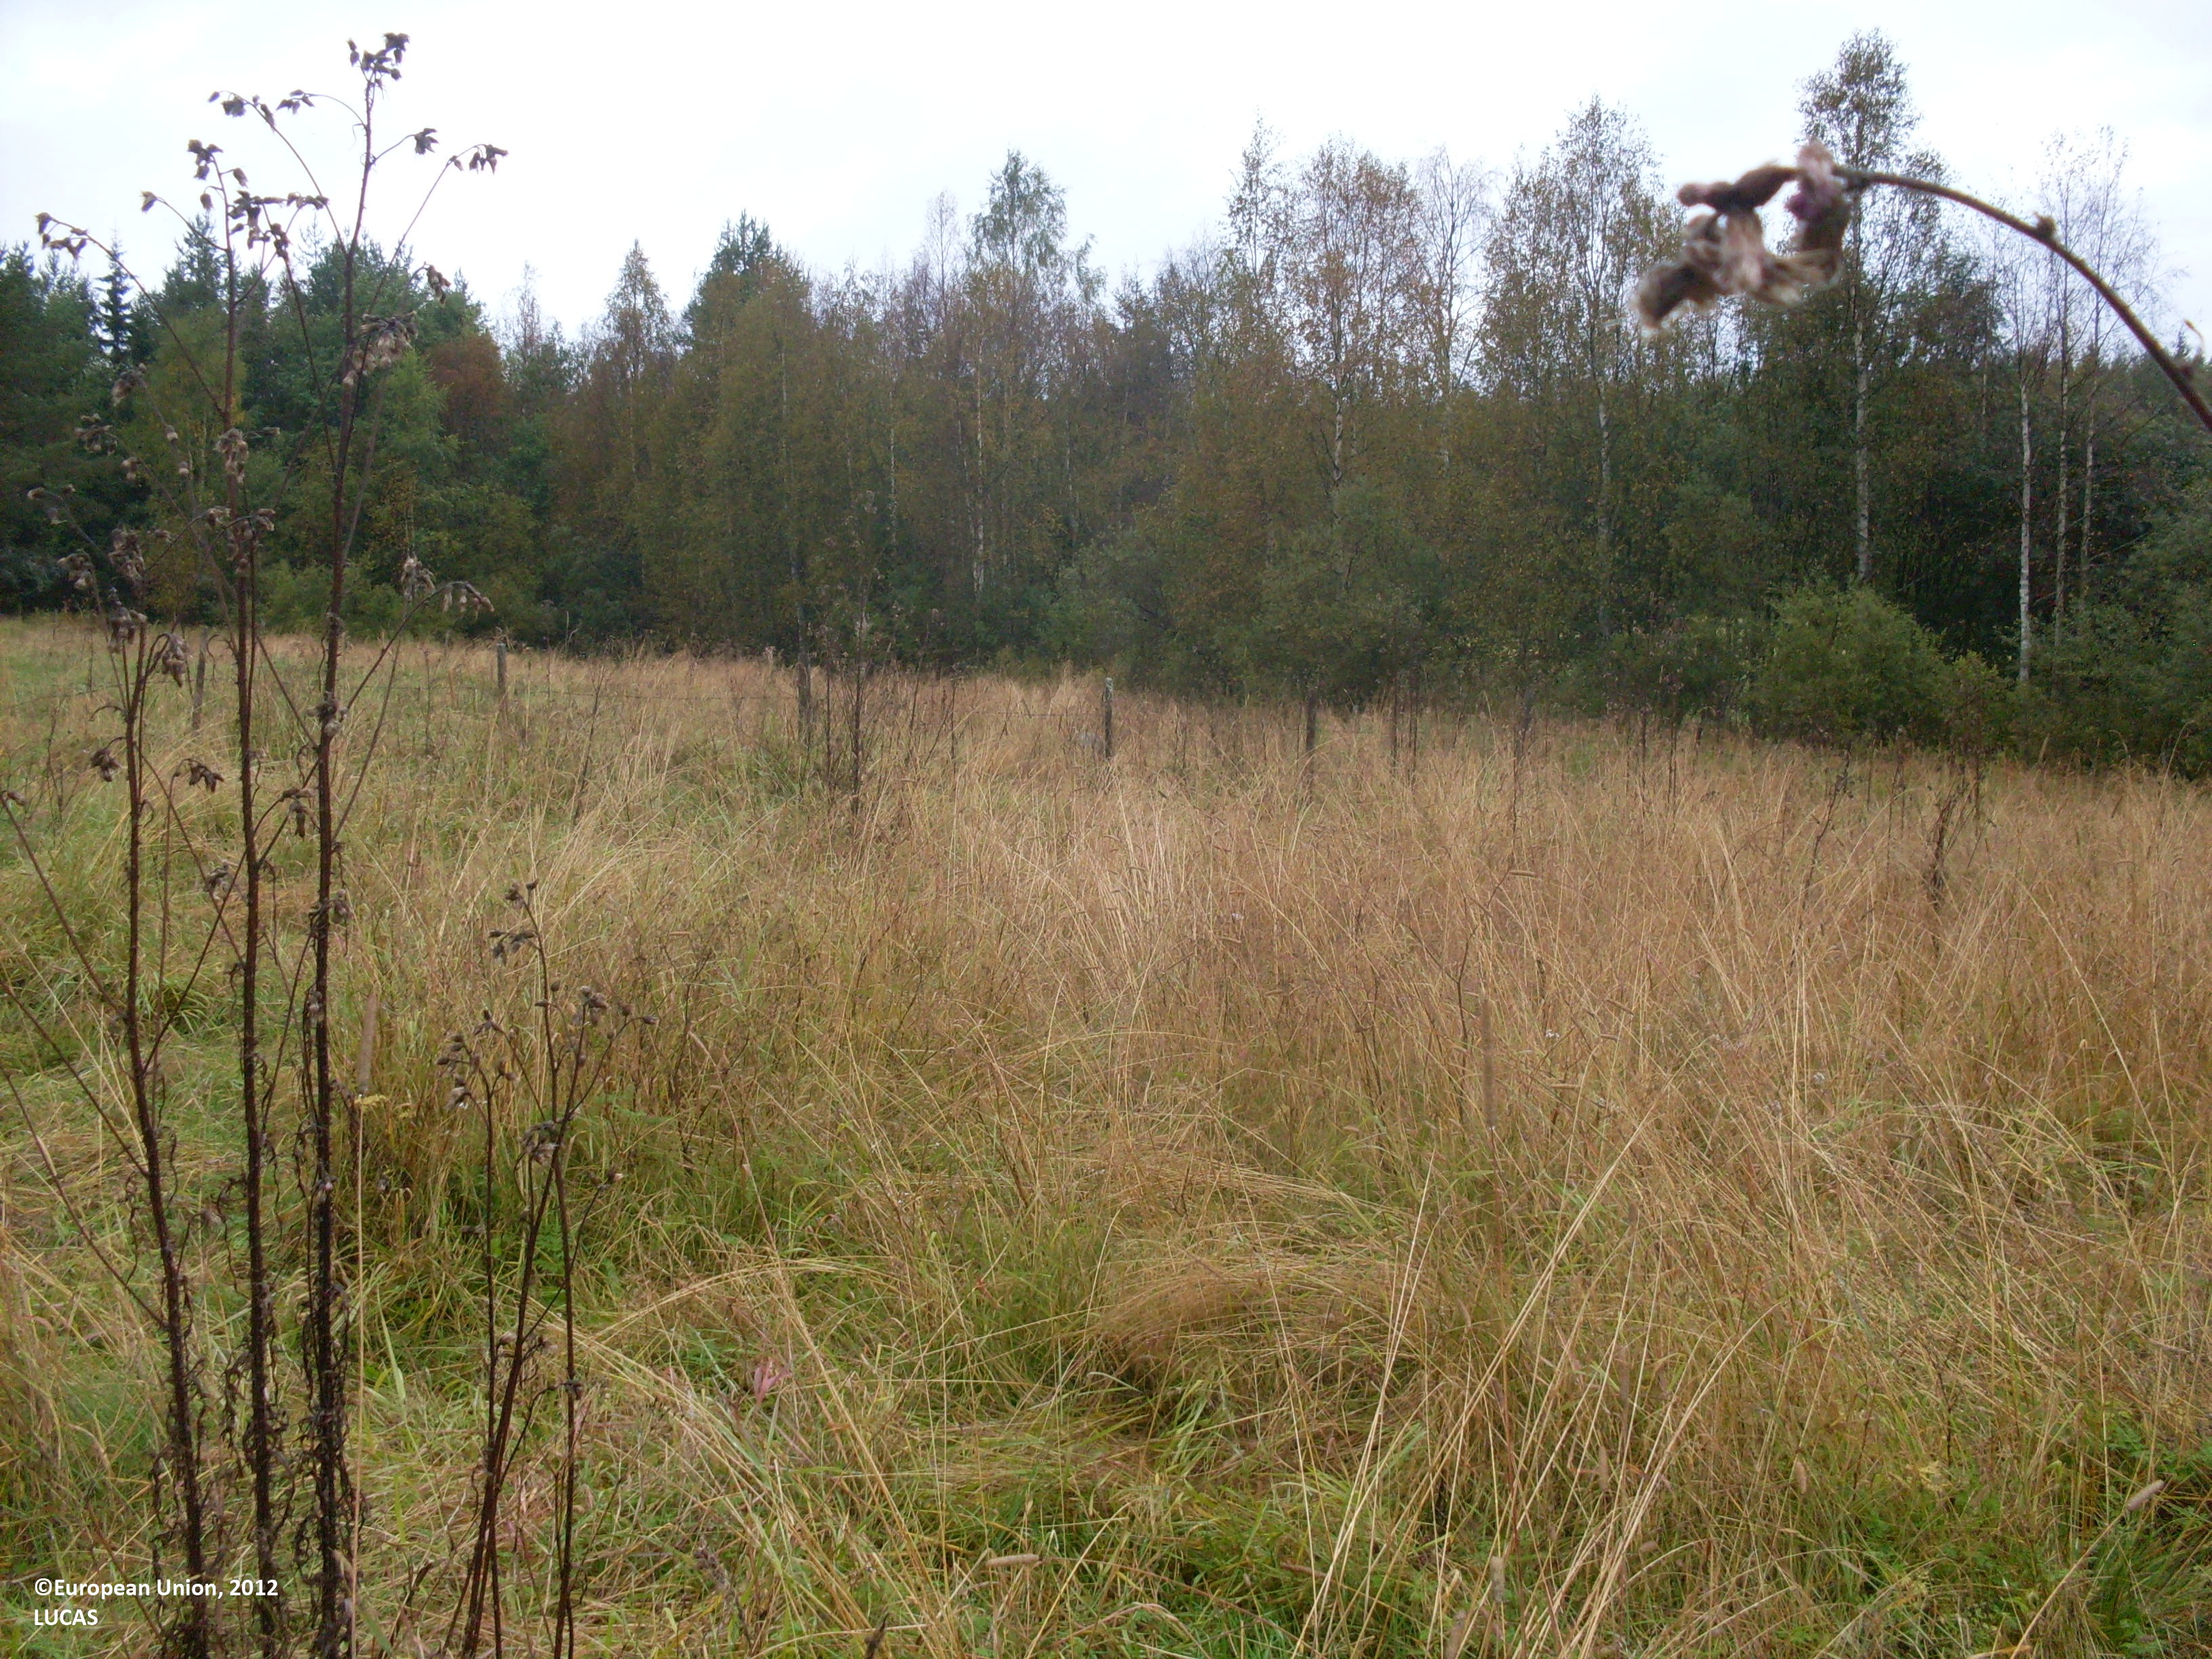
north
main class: Grassland
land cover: Grassland without tree/shrub cover
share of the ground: > 75 %
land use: Agriculture (excluding fallow land and kitchen gardens)
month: September
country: FI
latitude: 64.1477
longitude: 29.6054
